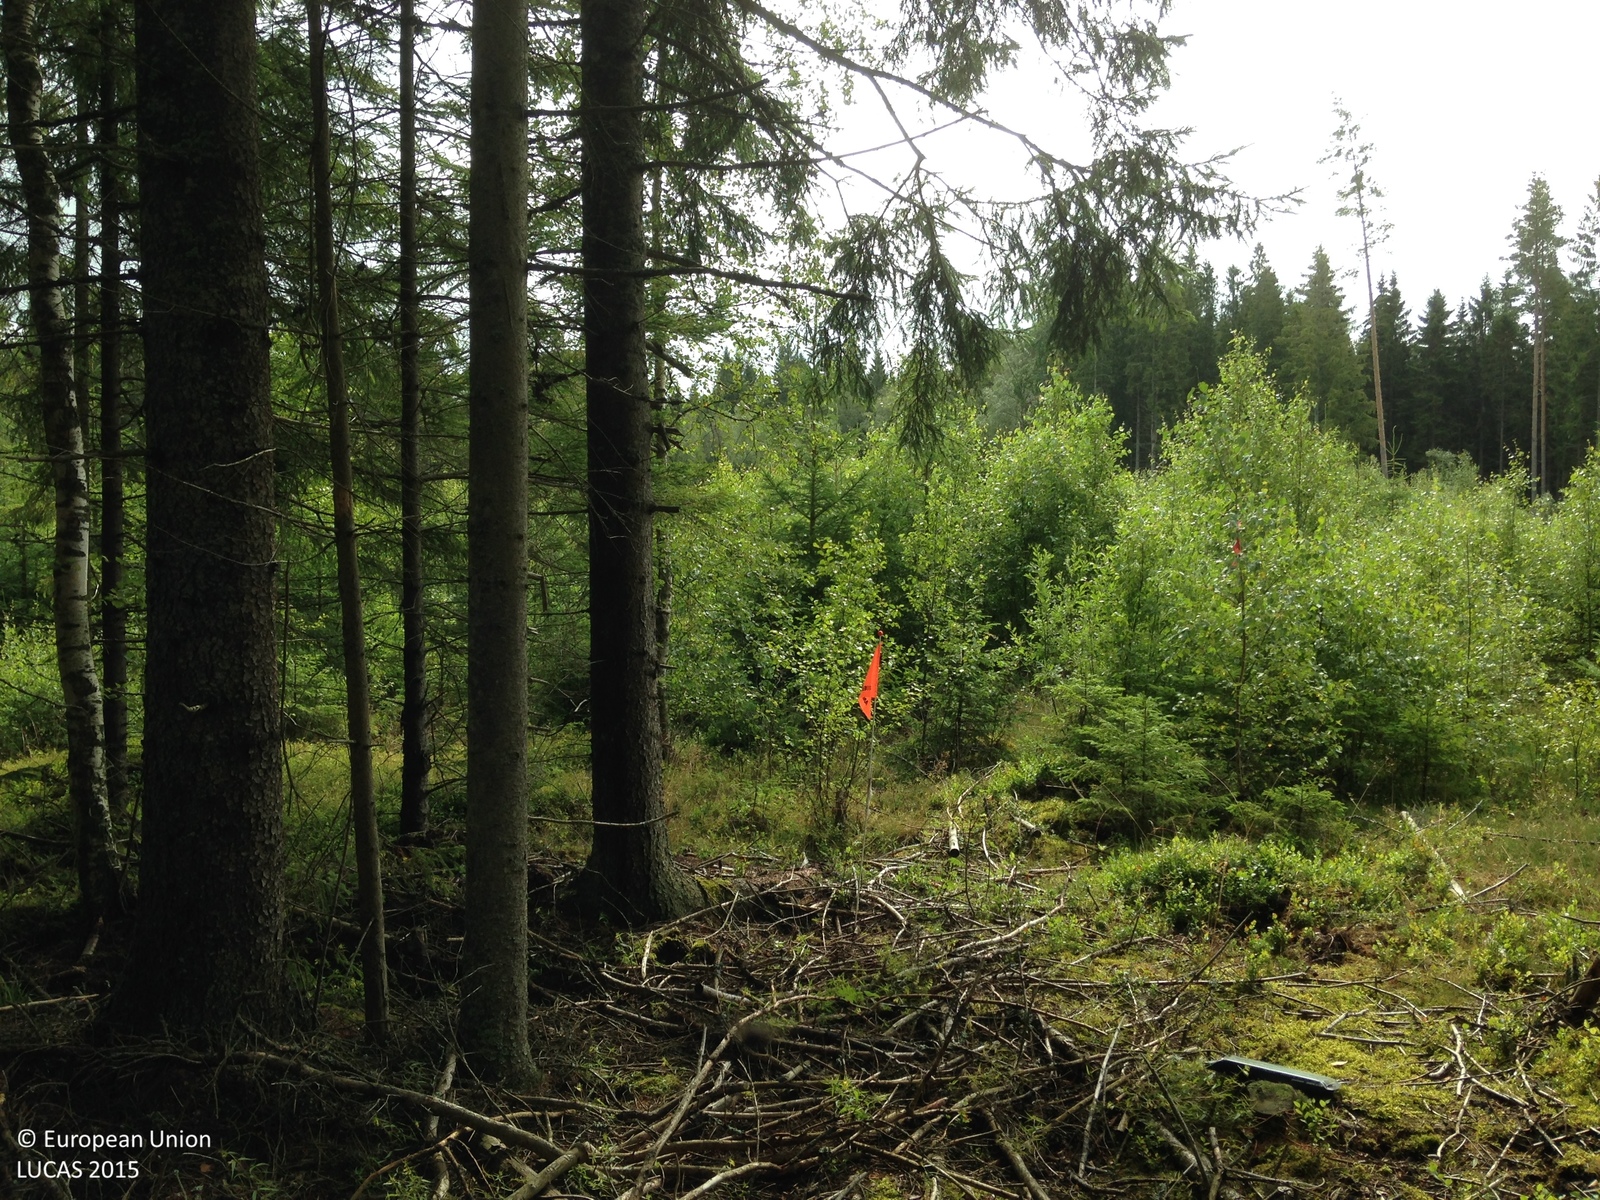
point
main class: Woodland
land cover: Spruce dominated mixed woodland
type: boreal forest
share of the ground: 25 - 50 %
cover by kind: herbaceous plants 30 %, coniferous forest trees 25 %, consolidated bare surface 20 %, broadleaved forest trees 15 %, lichens and mosses 10 %
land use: Forestry
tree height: > 5 m
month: July
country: SE
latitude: 58.9407
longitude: 14.3890
